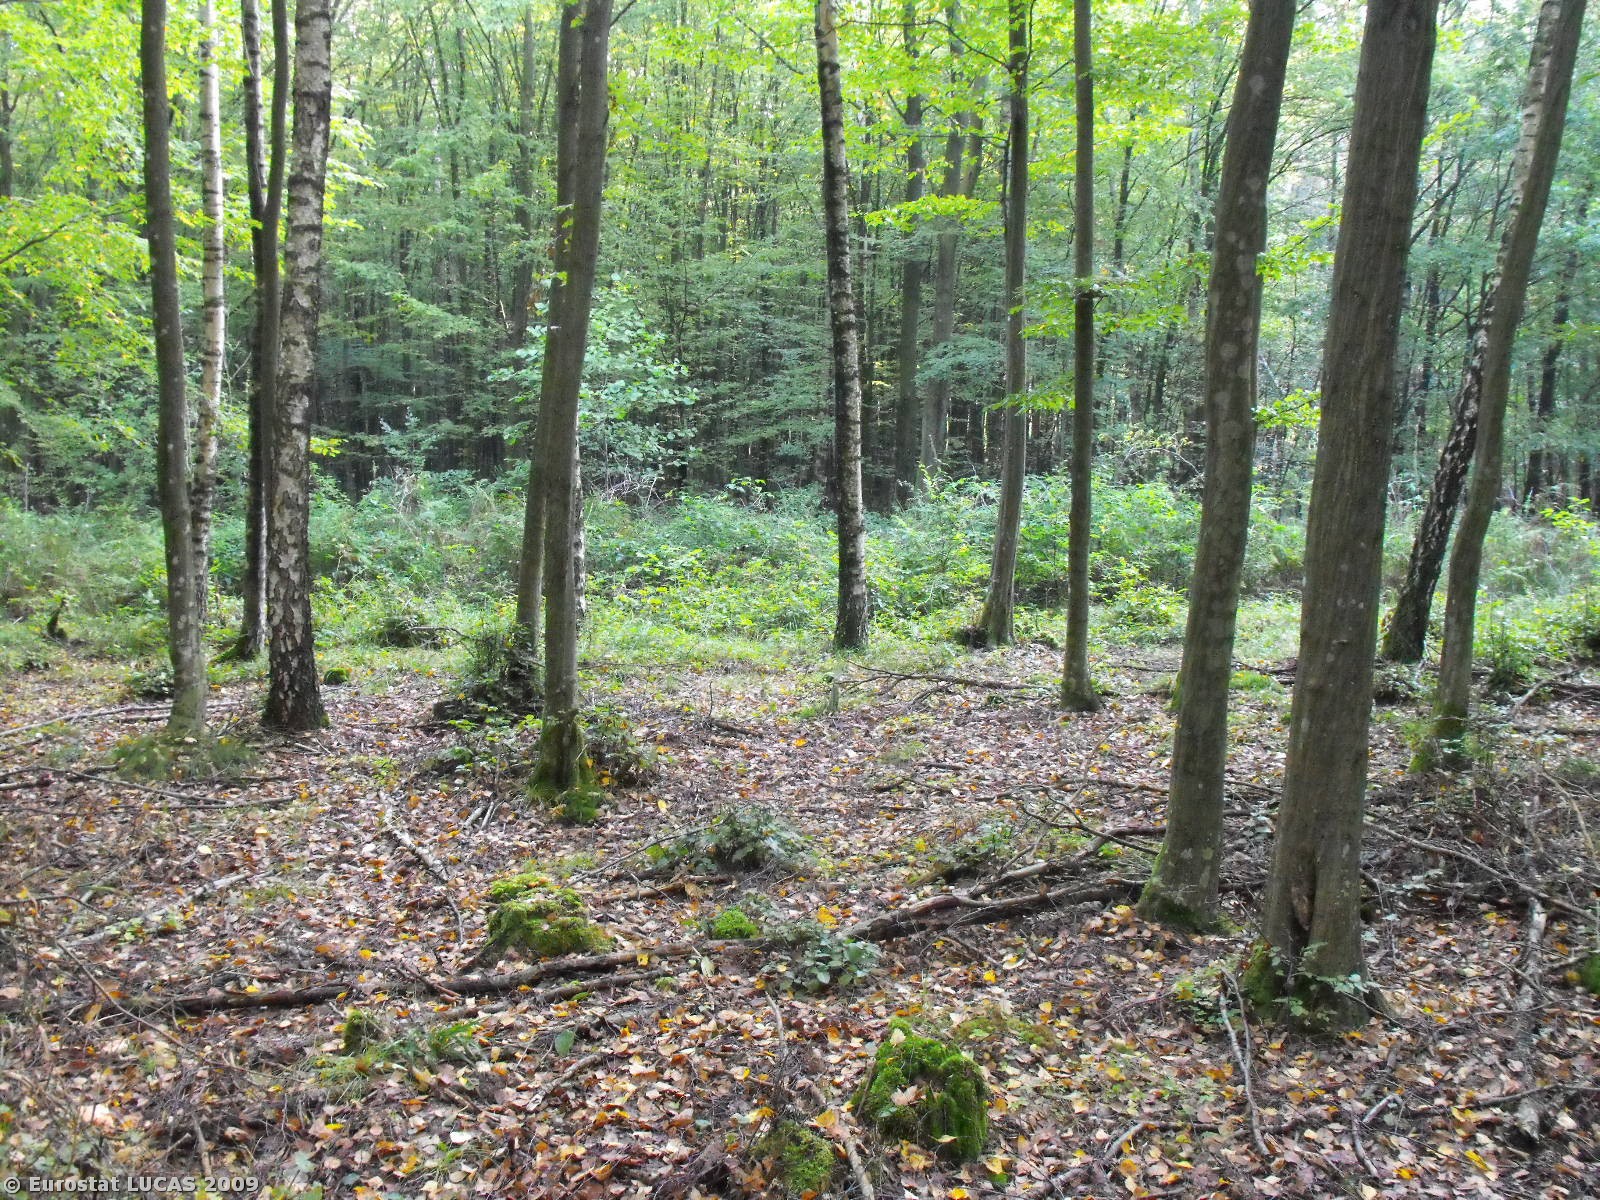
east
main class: Woodland
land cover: Broadleaved woodland
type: hemiboreal forest and nemoral coniferous forest and mixed broadleaved-coniferous forest
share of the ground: > 75 %
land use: Forestry
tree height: > 5 m
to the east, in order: Broadleaved woodland; Mixed woodland
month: September
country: PL
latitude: 54.3920
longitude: 16.6441
